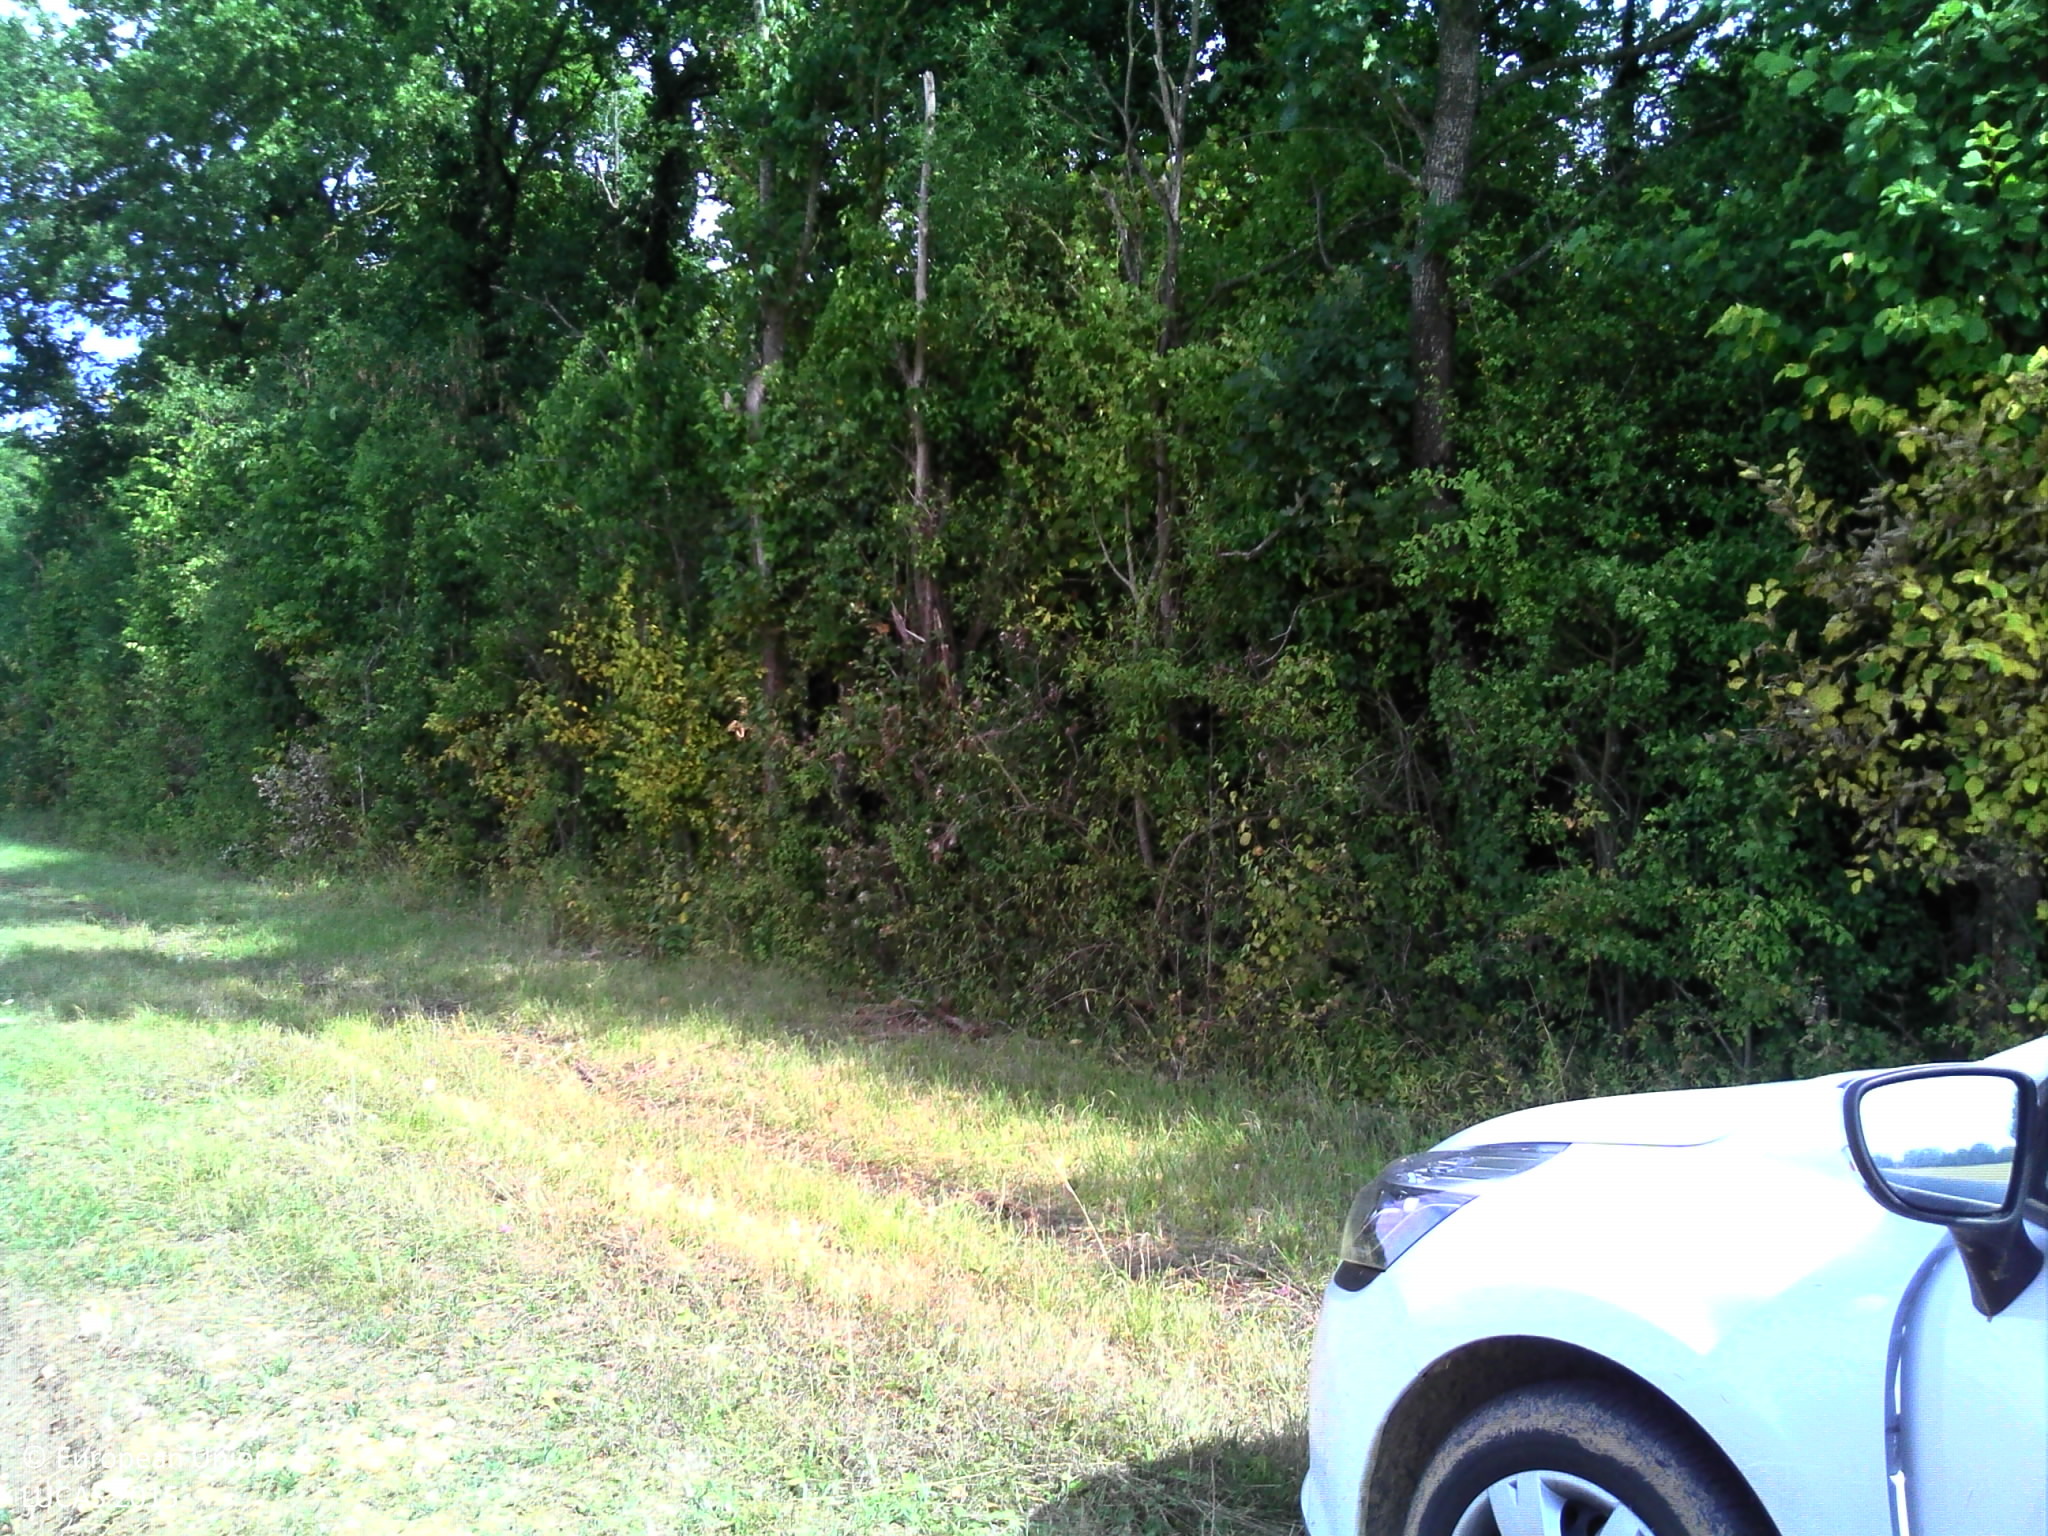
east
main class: Cropland
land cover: Sugar beet
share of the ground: > 75 %
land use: Agriculture (excluding fallow land and kitchen gardens)
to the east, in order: Sugar beet; Rape and turnip rape; Tracks; Broadleaved woodland
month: August
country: FR
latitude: 48.1649
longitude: 2.4740
